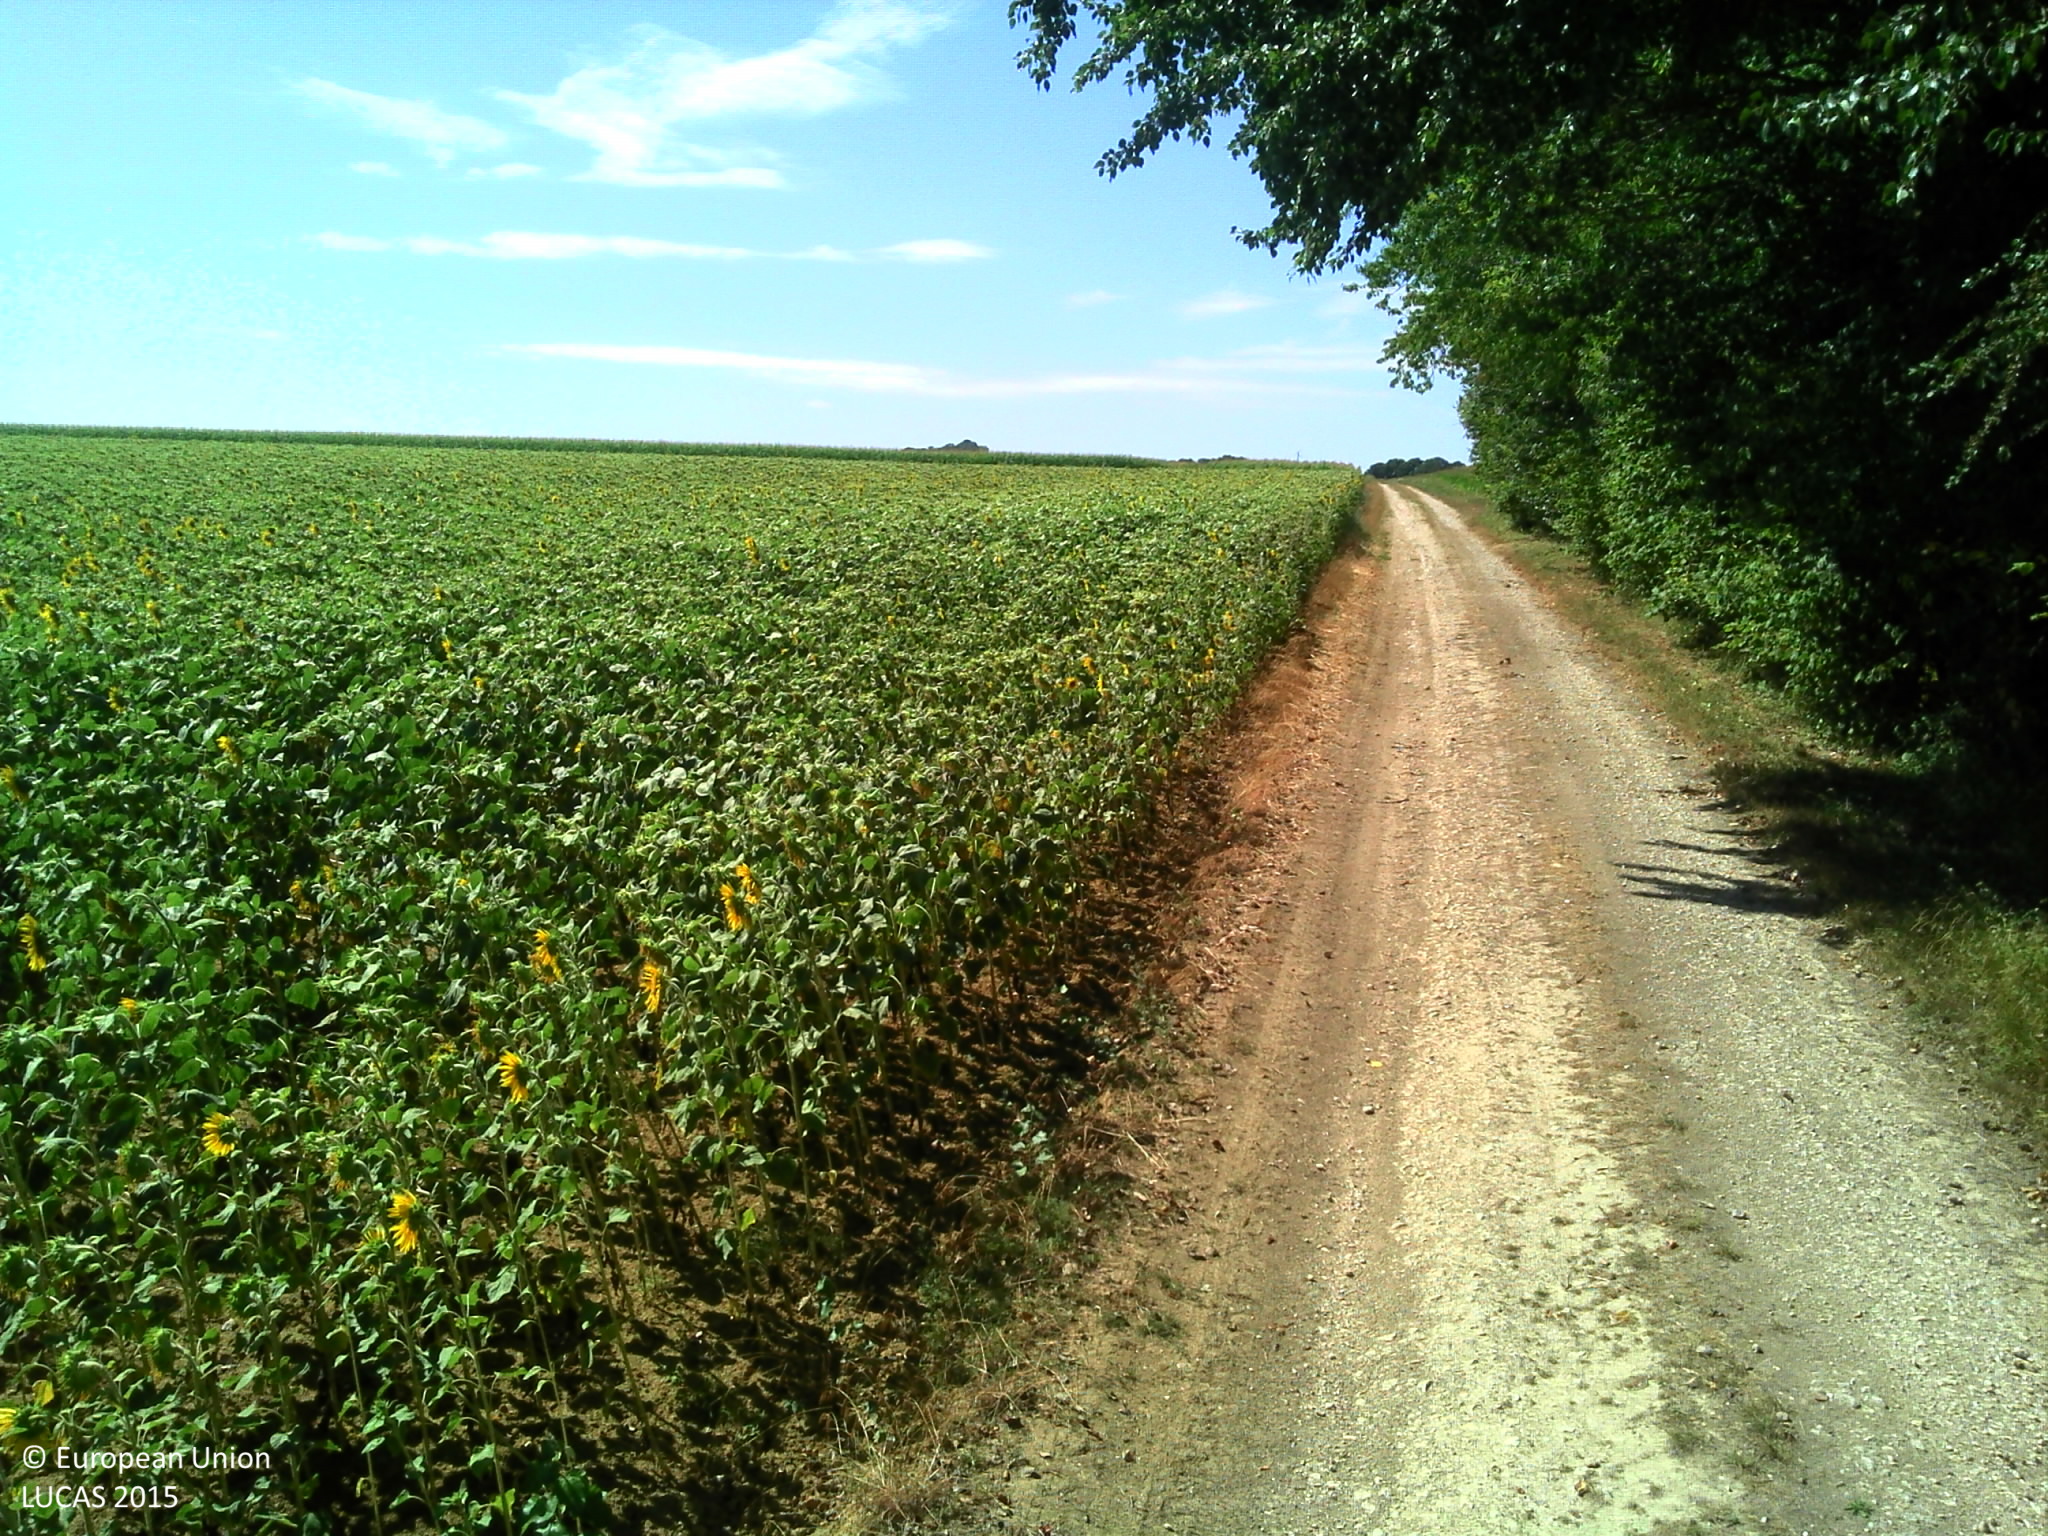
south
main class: Cropland
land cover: Sunflower
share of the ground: > 75 %
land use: Agriculture (excluding fallow land and kitchen gardens)
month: August
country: FR
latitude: 48.7249
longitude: 3.3183
